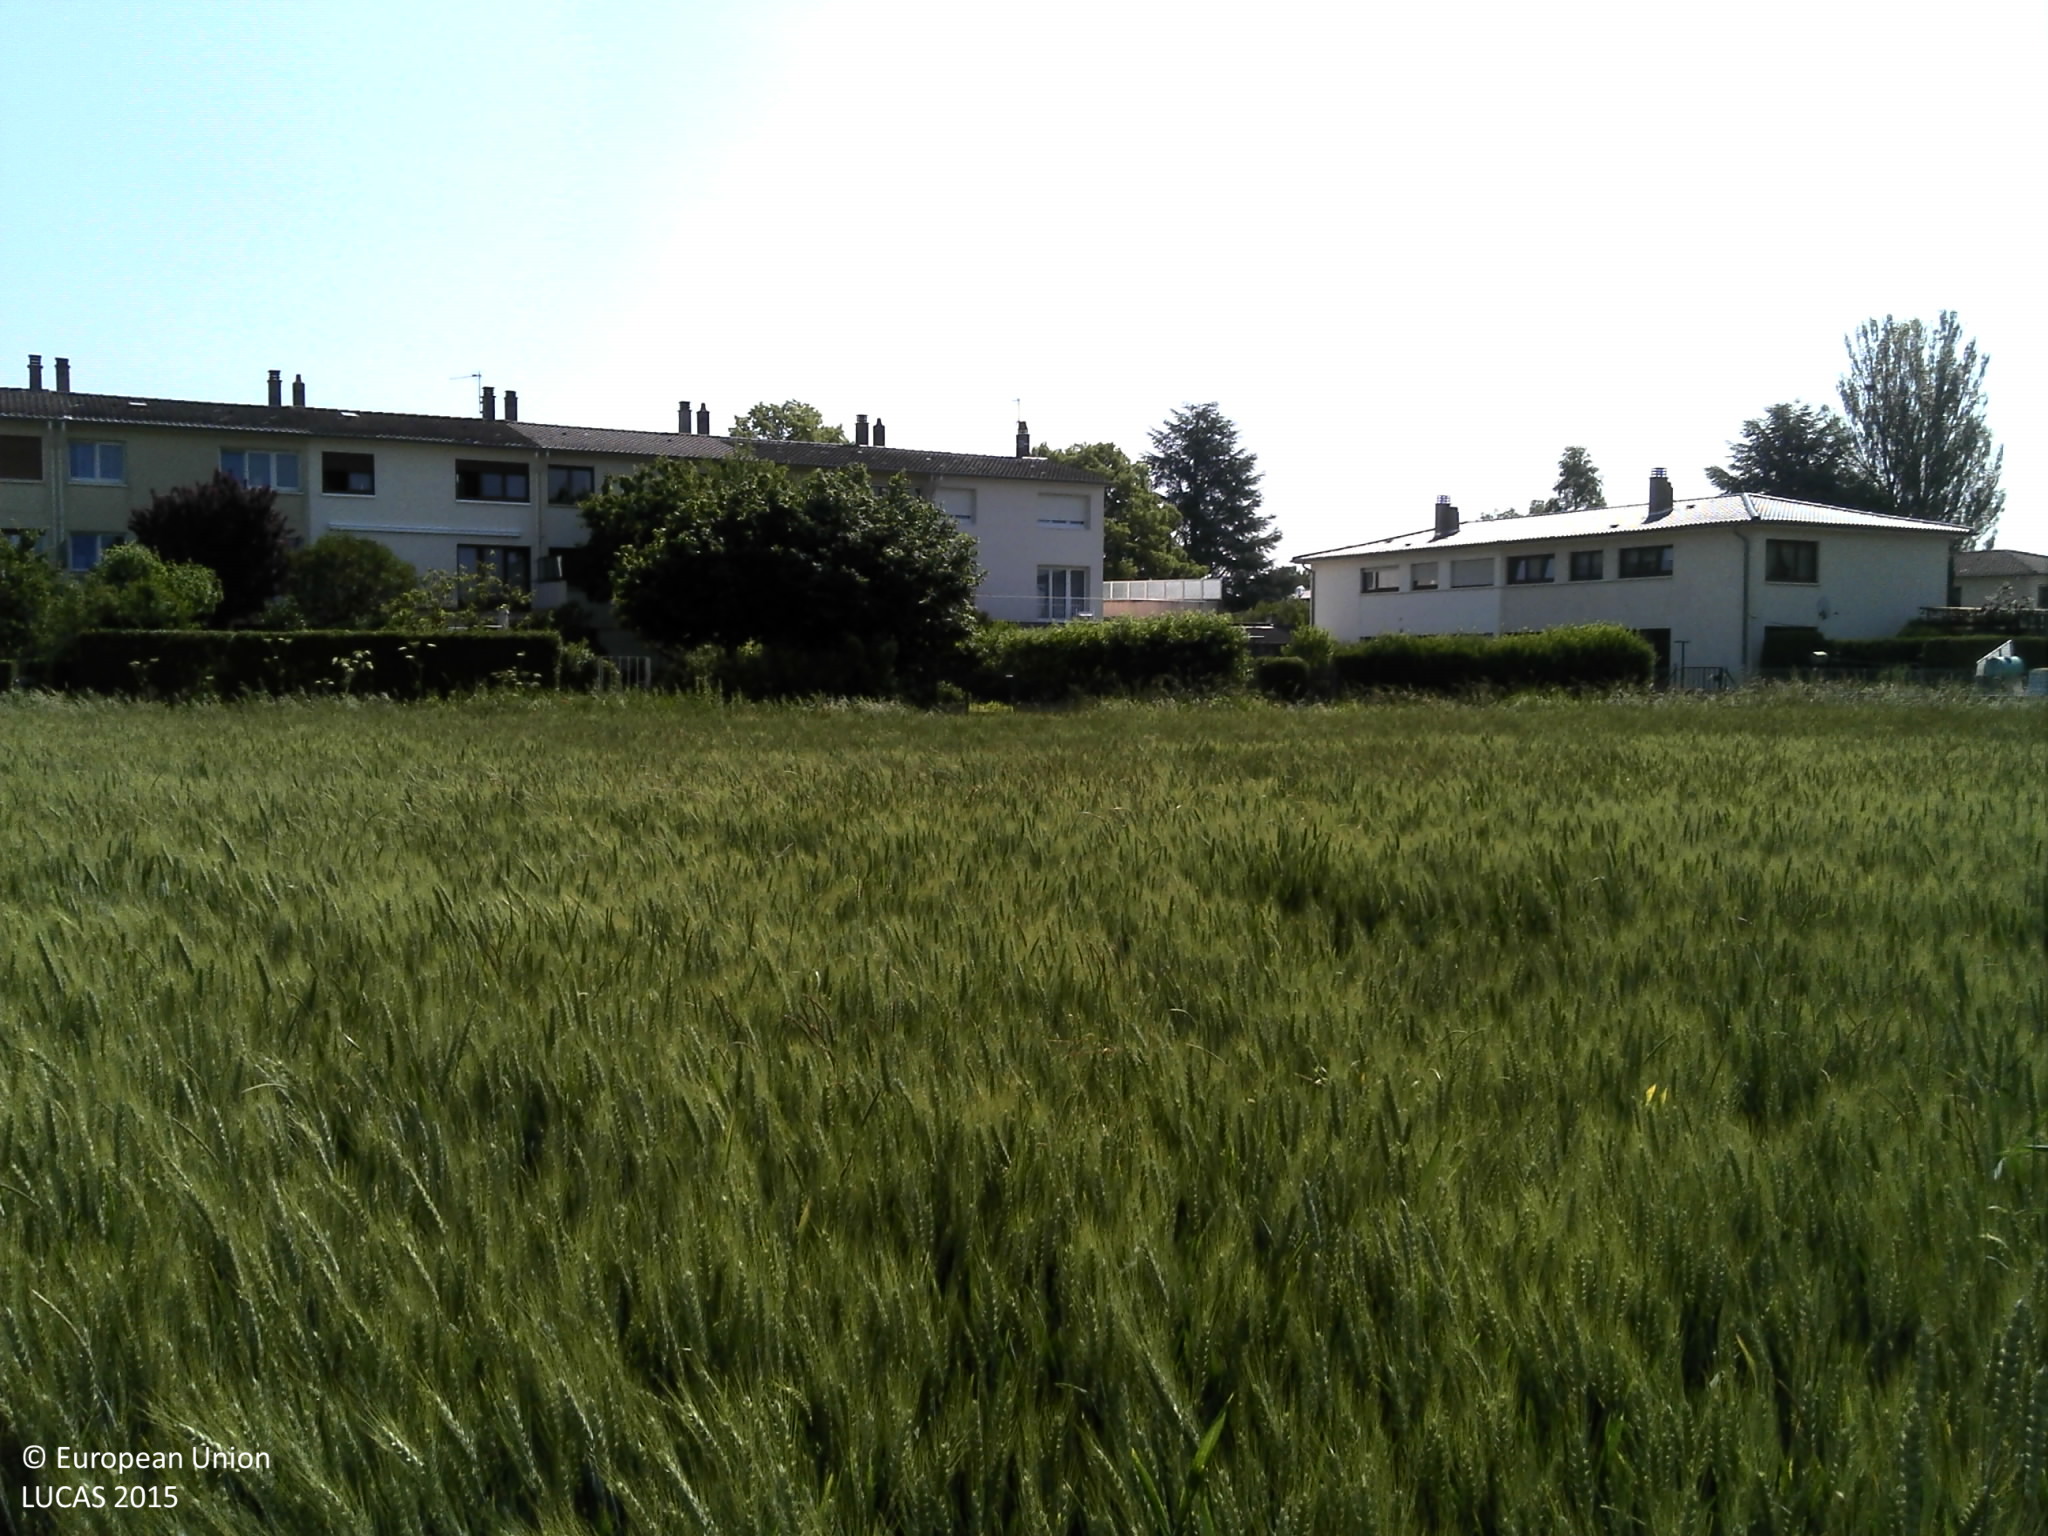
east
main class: Cropland
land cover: Common wheat
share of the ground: > 75 %
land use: Agriculture (excluding fallow land and kitchen gardens)
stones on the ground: < 10 %
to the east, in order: Common wheat; Grass margins; Paved roads, cycling and walking lanes; Grass margins; Artificial constructions in urban areas; Shrubland without tree cover; Grassland without tree/shrub cover; Ditches and canals; Grass margins; Paved roads, cycling and walking lanes; Single bushes/trees; Grassland without tree/shrub cover; Other fruit trees and berries
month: June
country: FR
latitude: 49.0571
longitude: 6.1544
